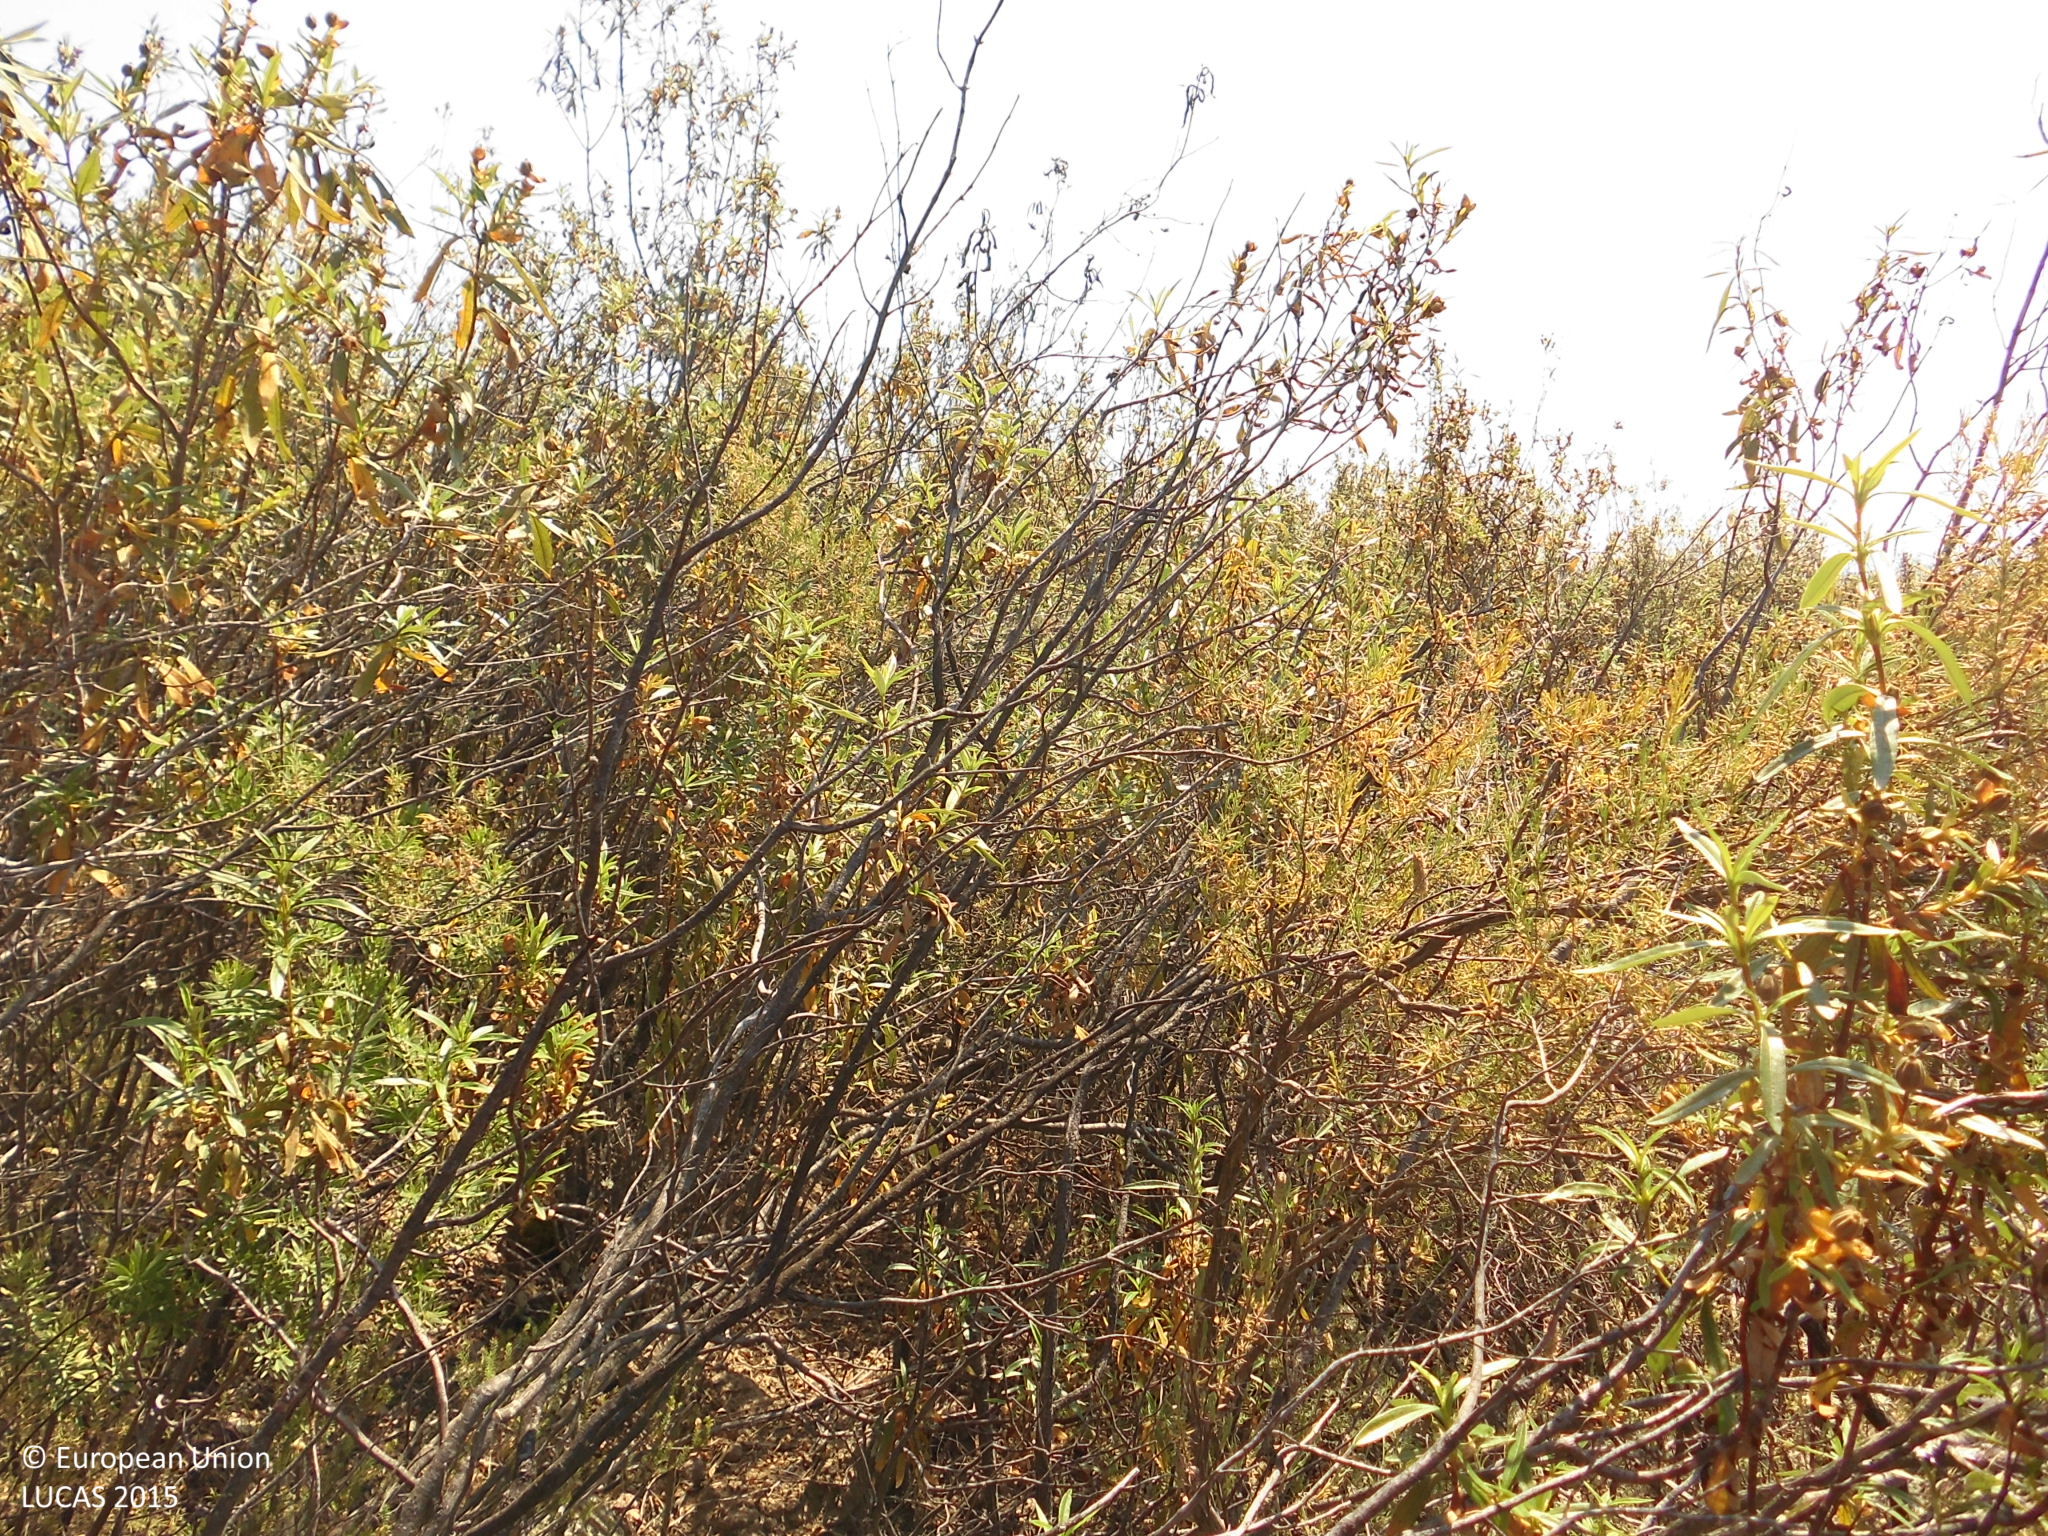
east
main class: Shrubland
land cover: Shrubland without tree cover
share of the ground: > 75 %
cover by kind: shrubs 90 %, herbaceous plants 10 %
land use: Abandoned areas
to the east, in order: Shrubland without tree cover; Grassland without tree/shrub cover; Tracks; Pine dominated coniferous woodland; Tracks; Pine dominated coniferous woodland; Paved roads, cycling and walking lanes; Pine dominated coniferous woodland
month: June
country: ES
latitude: 40.0956
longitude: -5.4855
